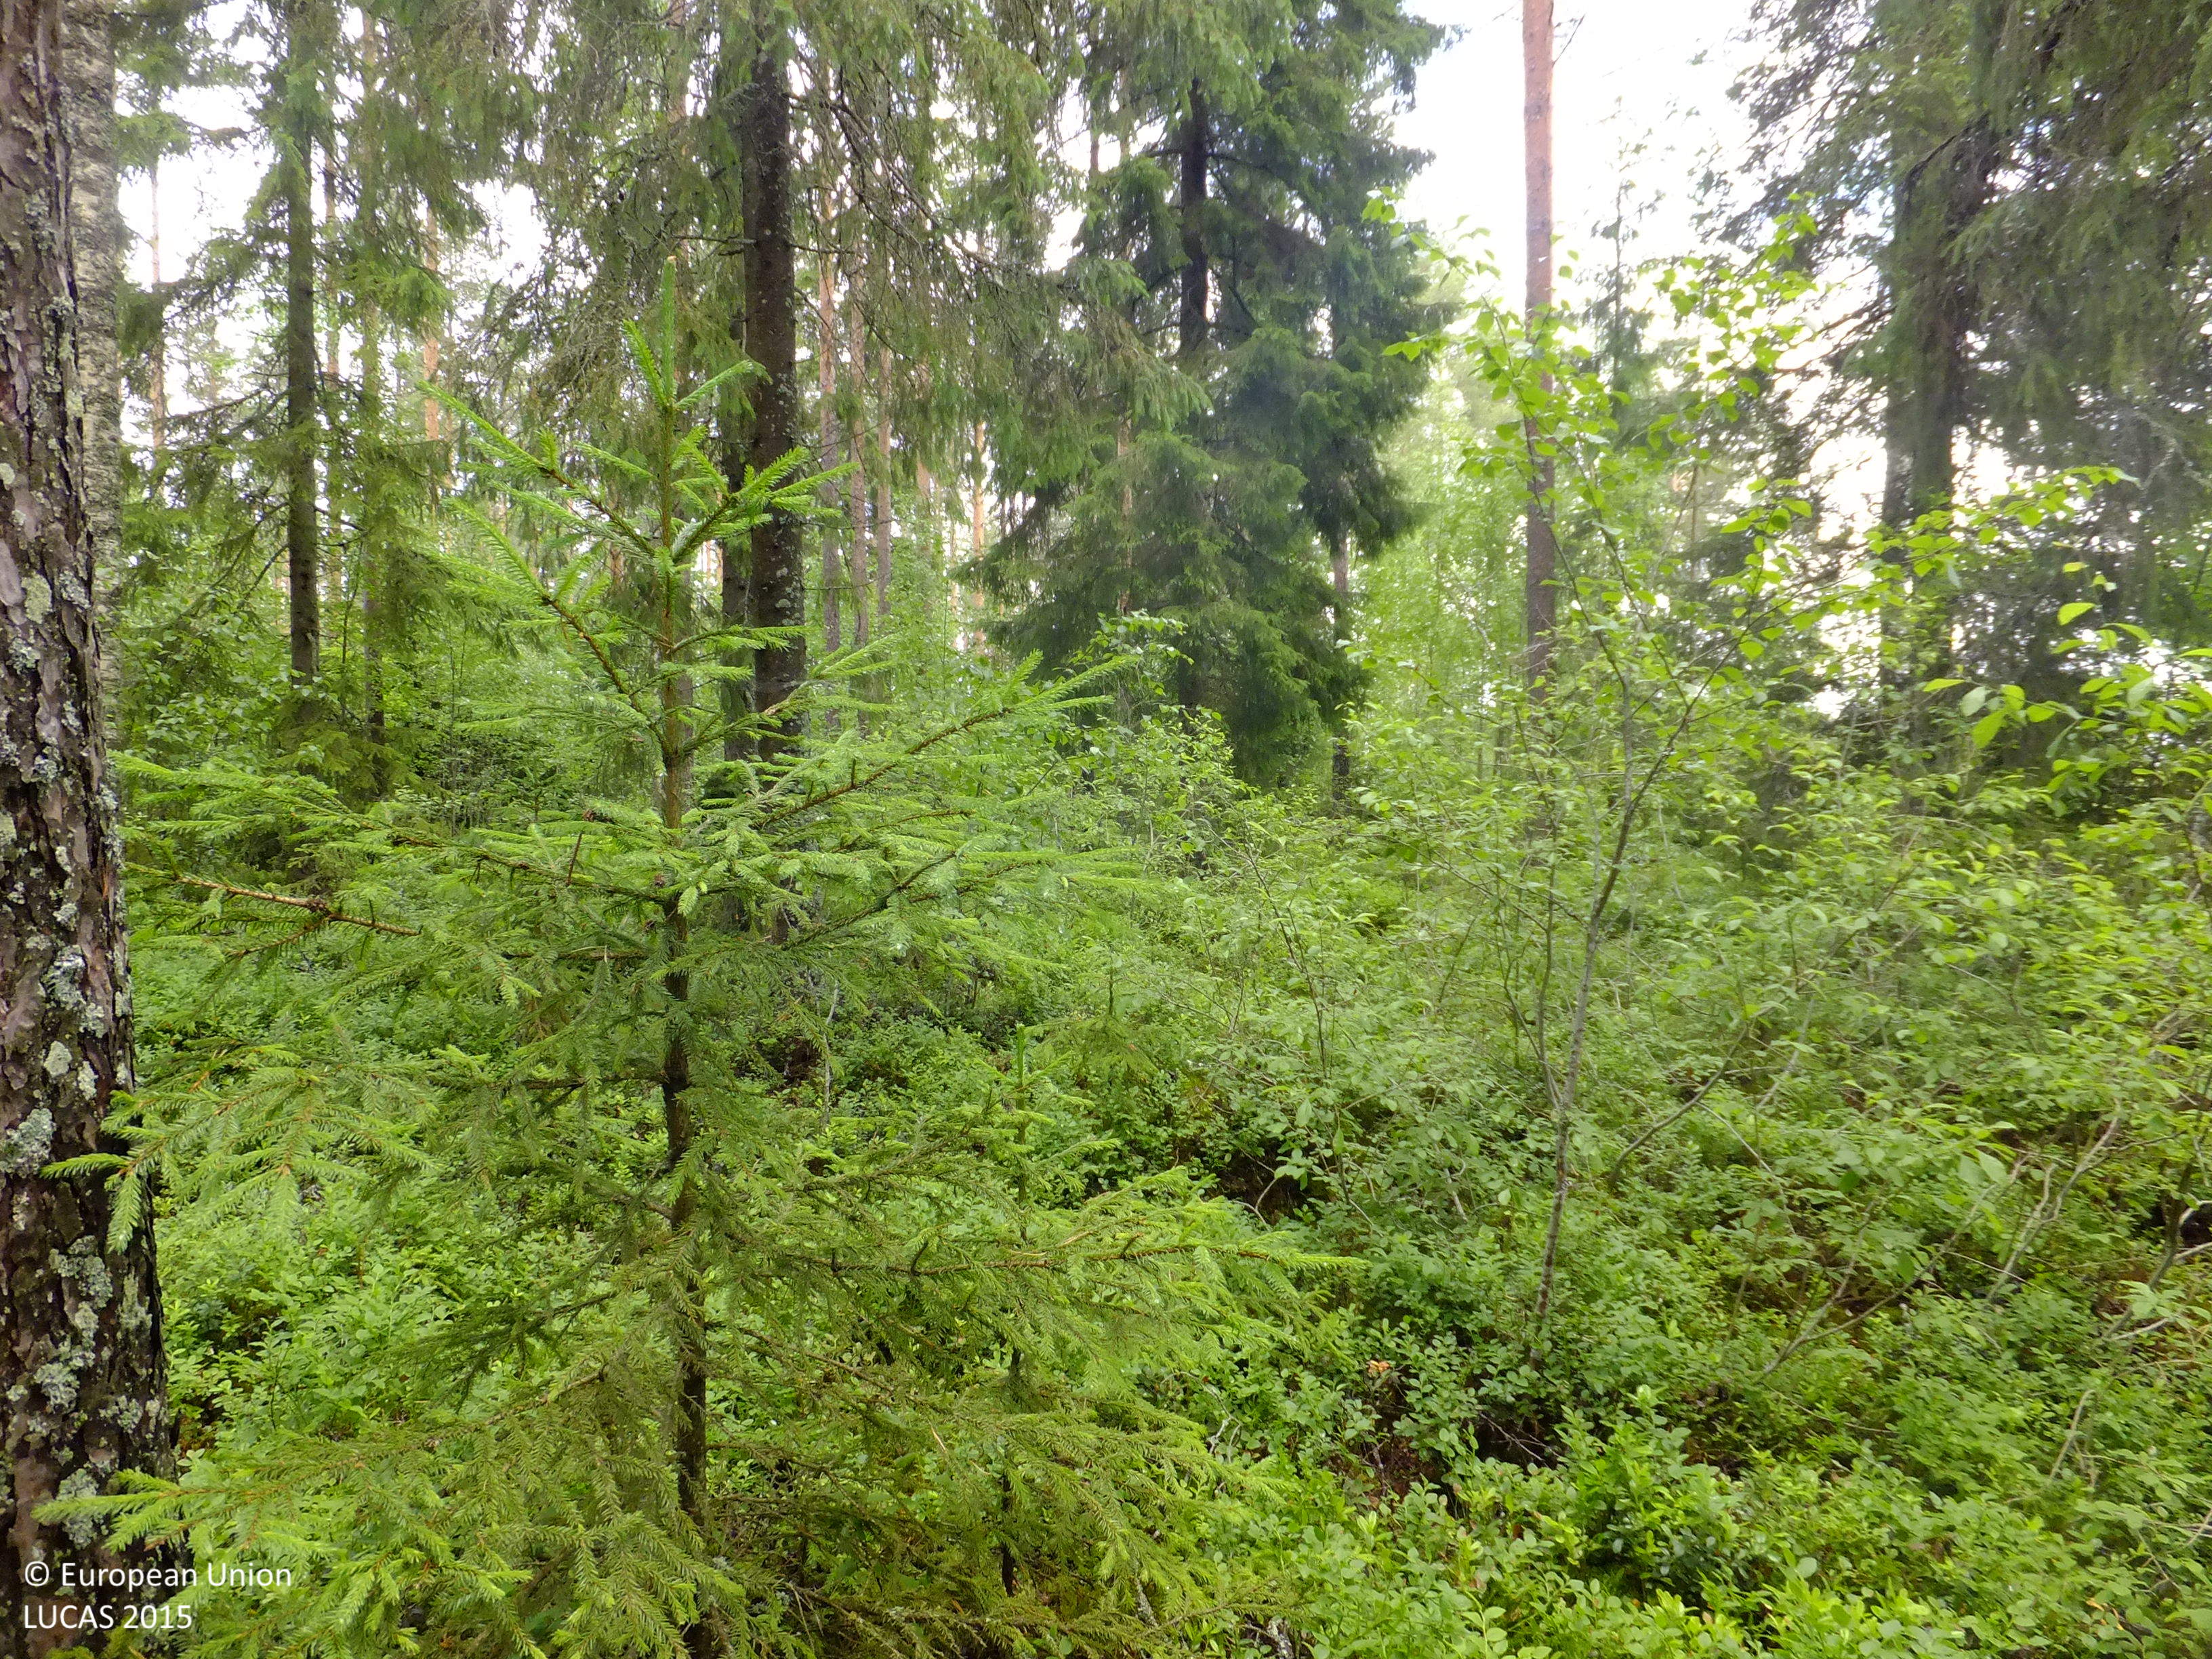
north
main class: Woodland
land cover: Other mixed woodland
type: boreal forest
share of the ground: > 75 %
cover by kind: broadleaved forest trees 50 %, coniferous forest trees 35 %, shrubs 10 %, herbaceous plants 5 %
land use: Forestry
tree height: > 5 m
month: July
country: FI
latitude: 63.0949
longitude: 24.5649
